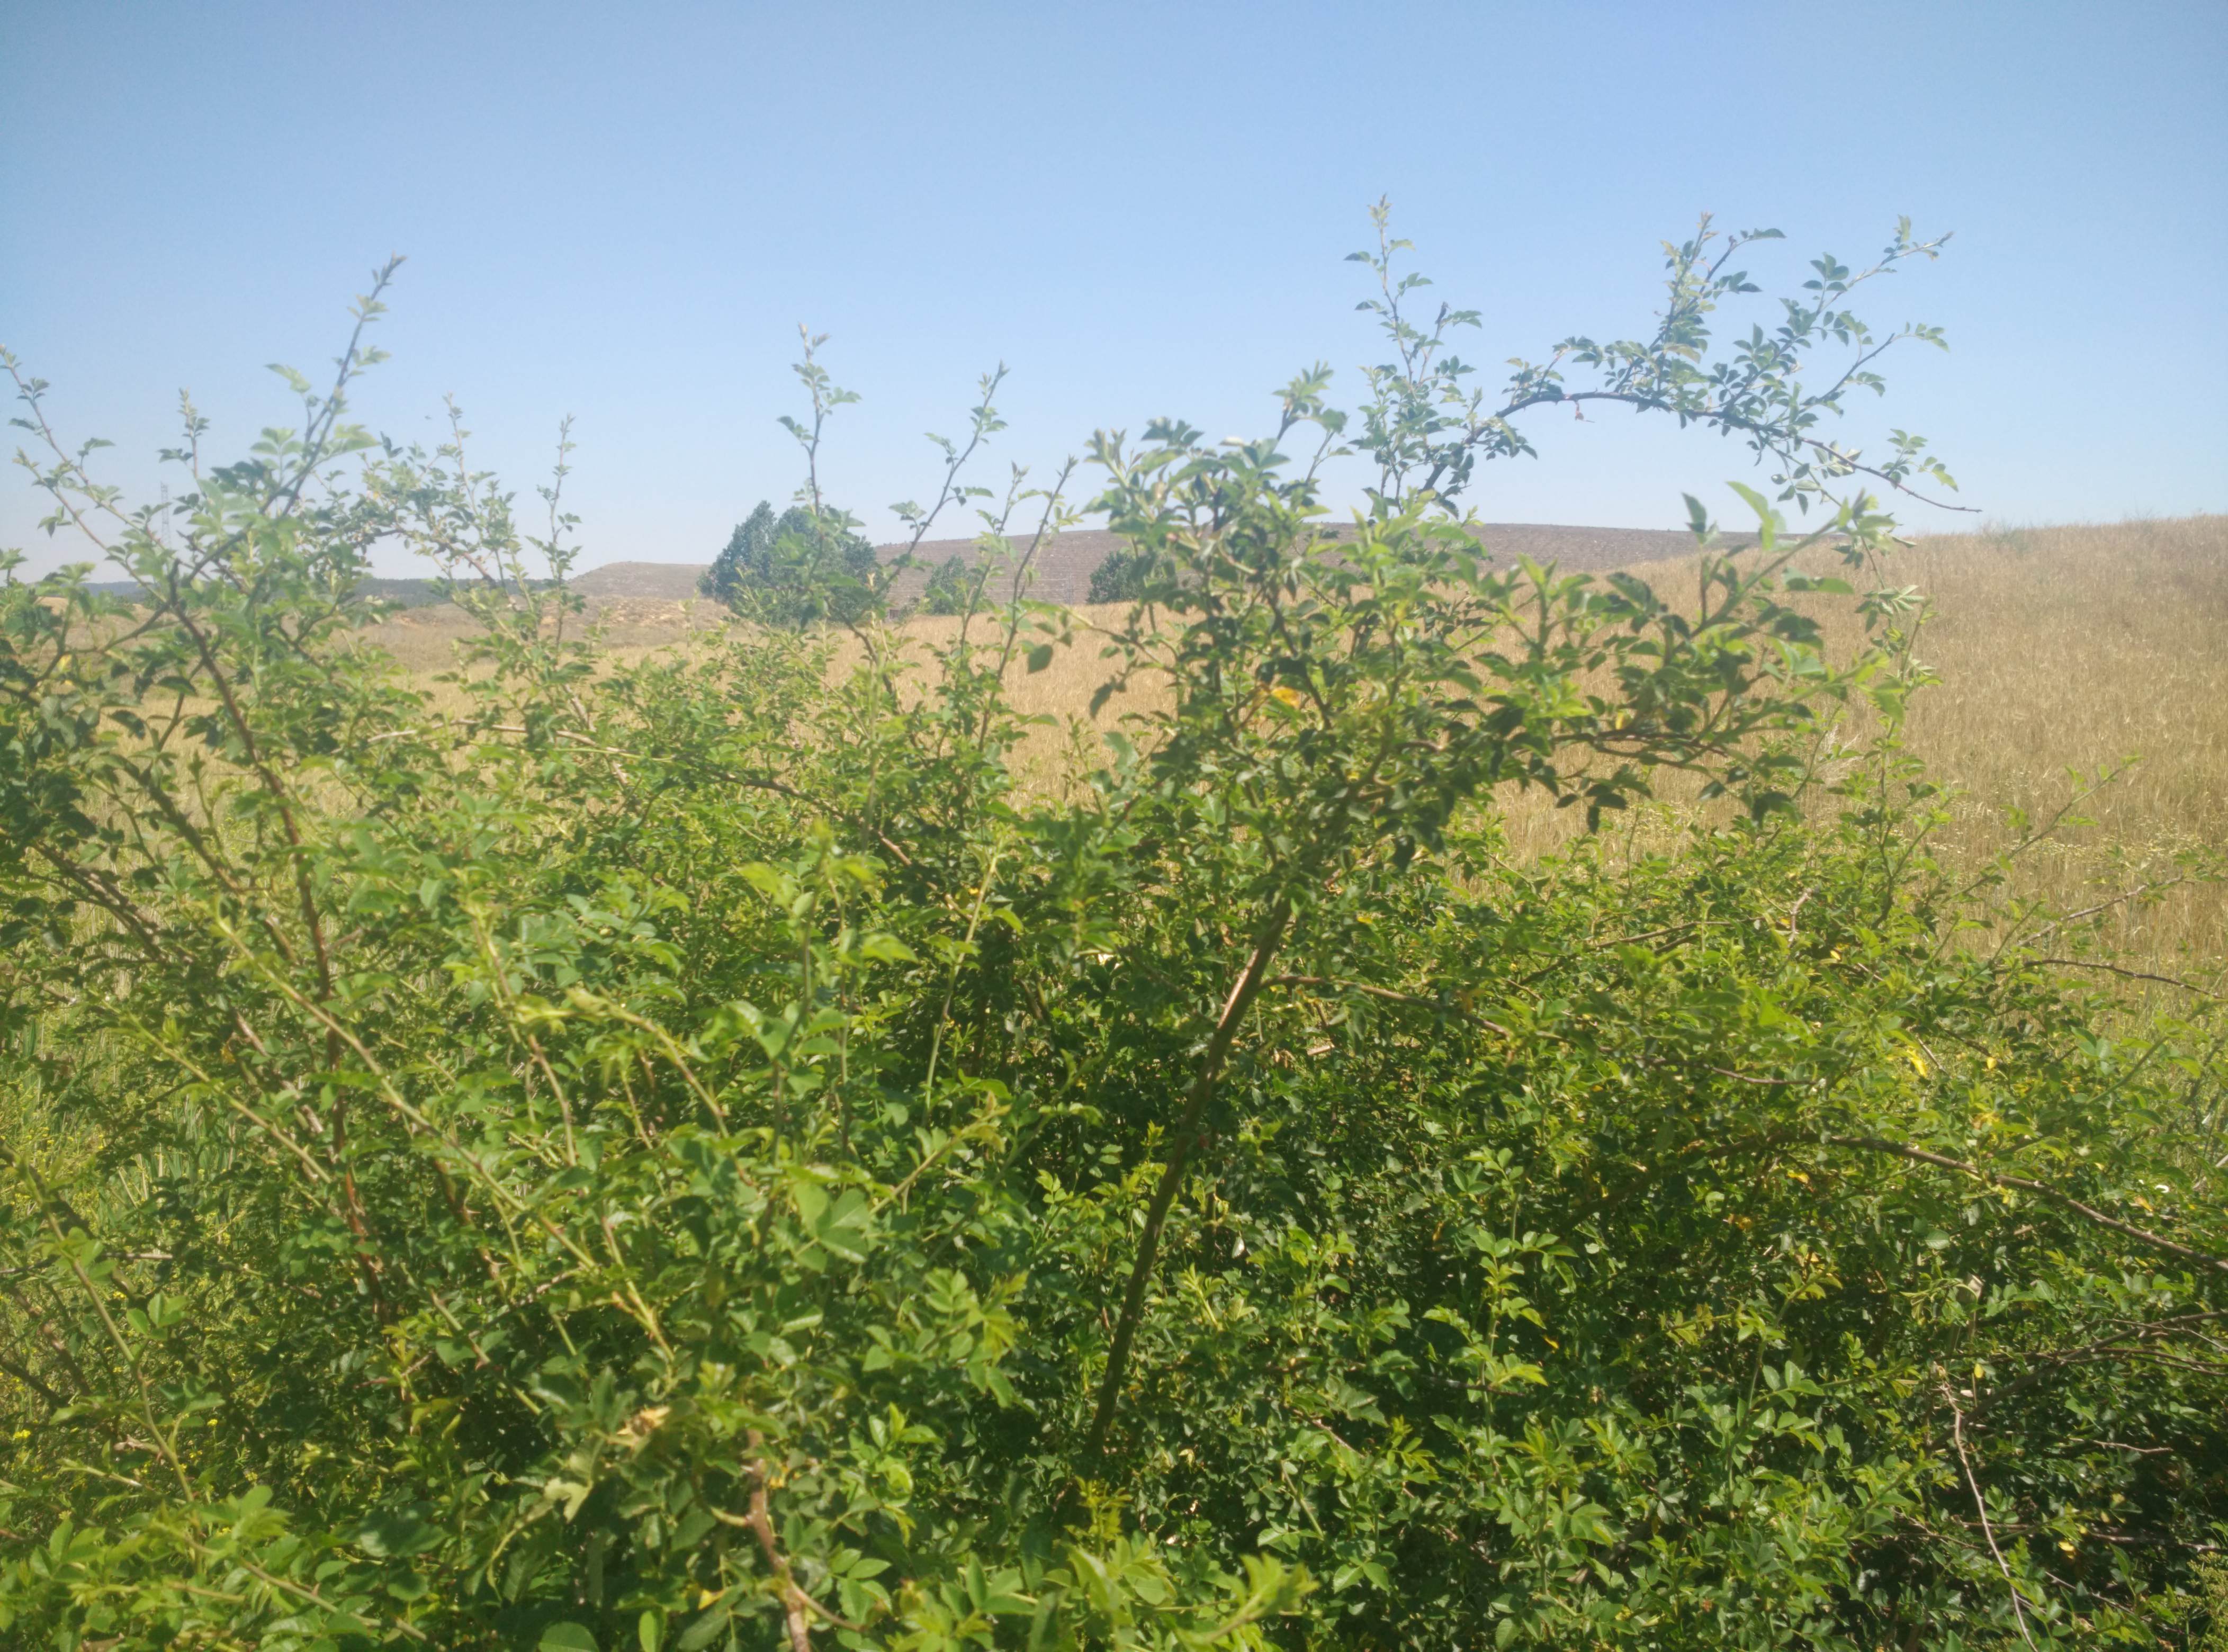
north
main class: Grassland
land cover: Grassland without tree/shrub cover
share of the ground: > 75 %
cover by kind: herbaceous plants 95 %, shrubs 5 %
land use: Semi-natural and natural areas not in use
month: June
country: ES
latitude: 40.8255
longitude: -1.8433
